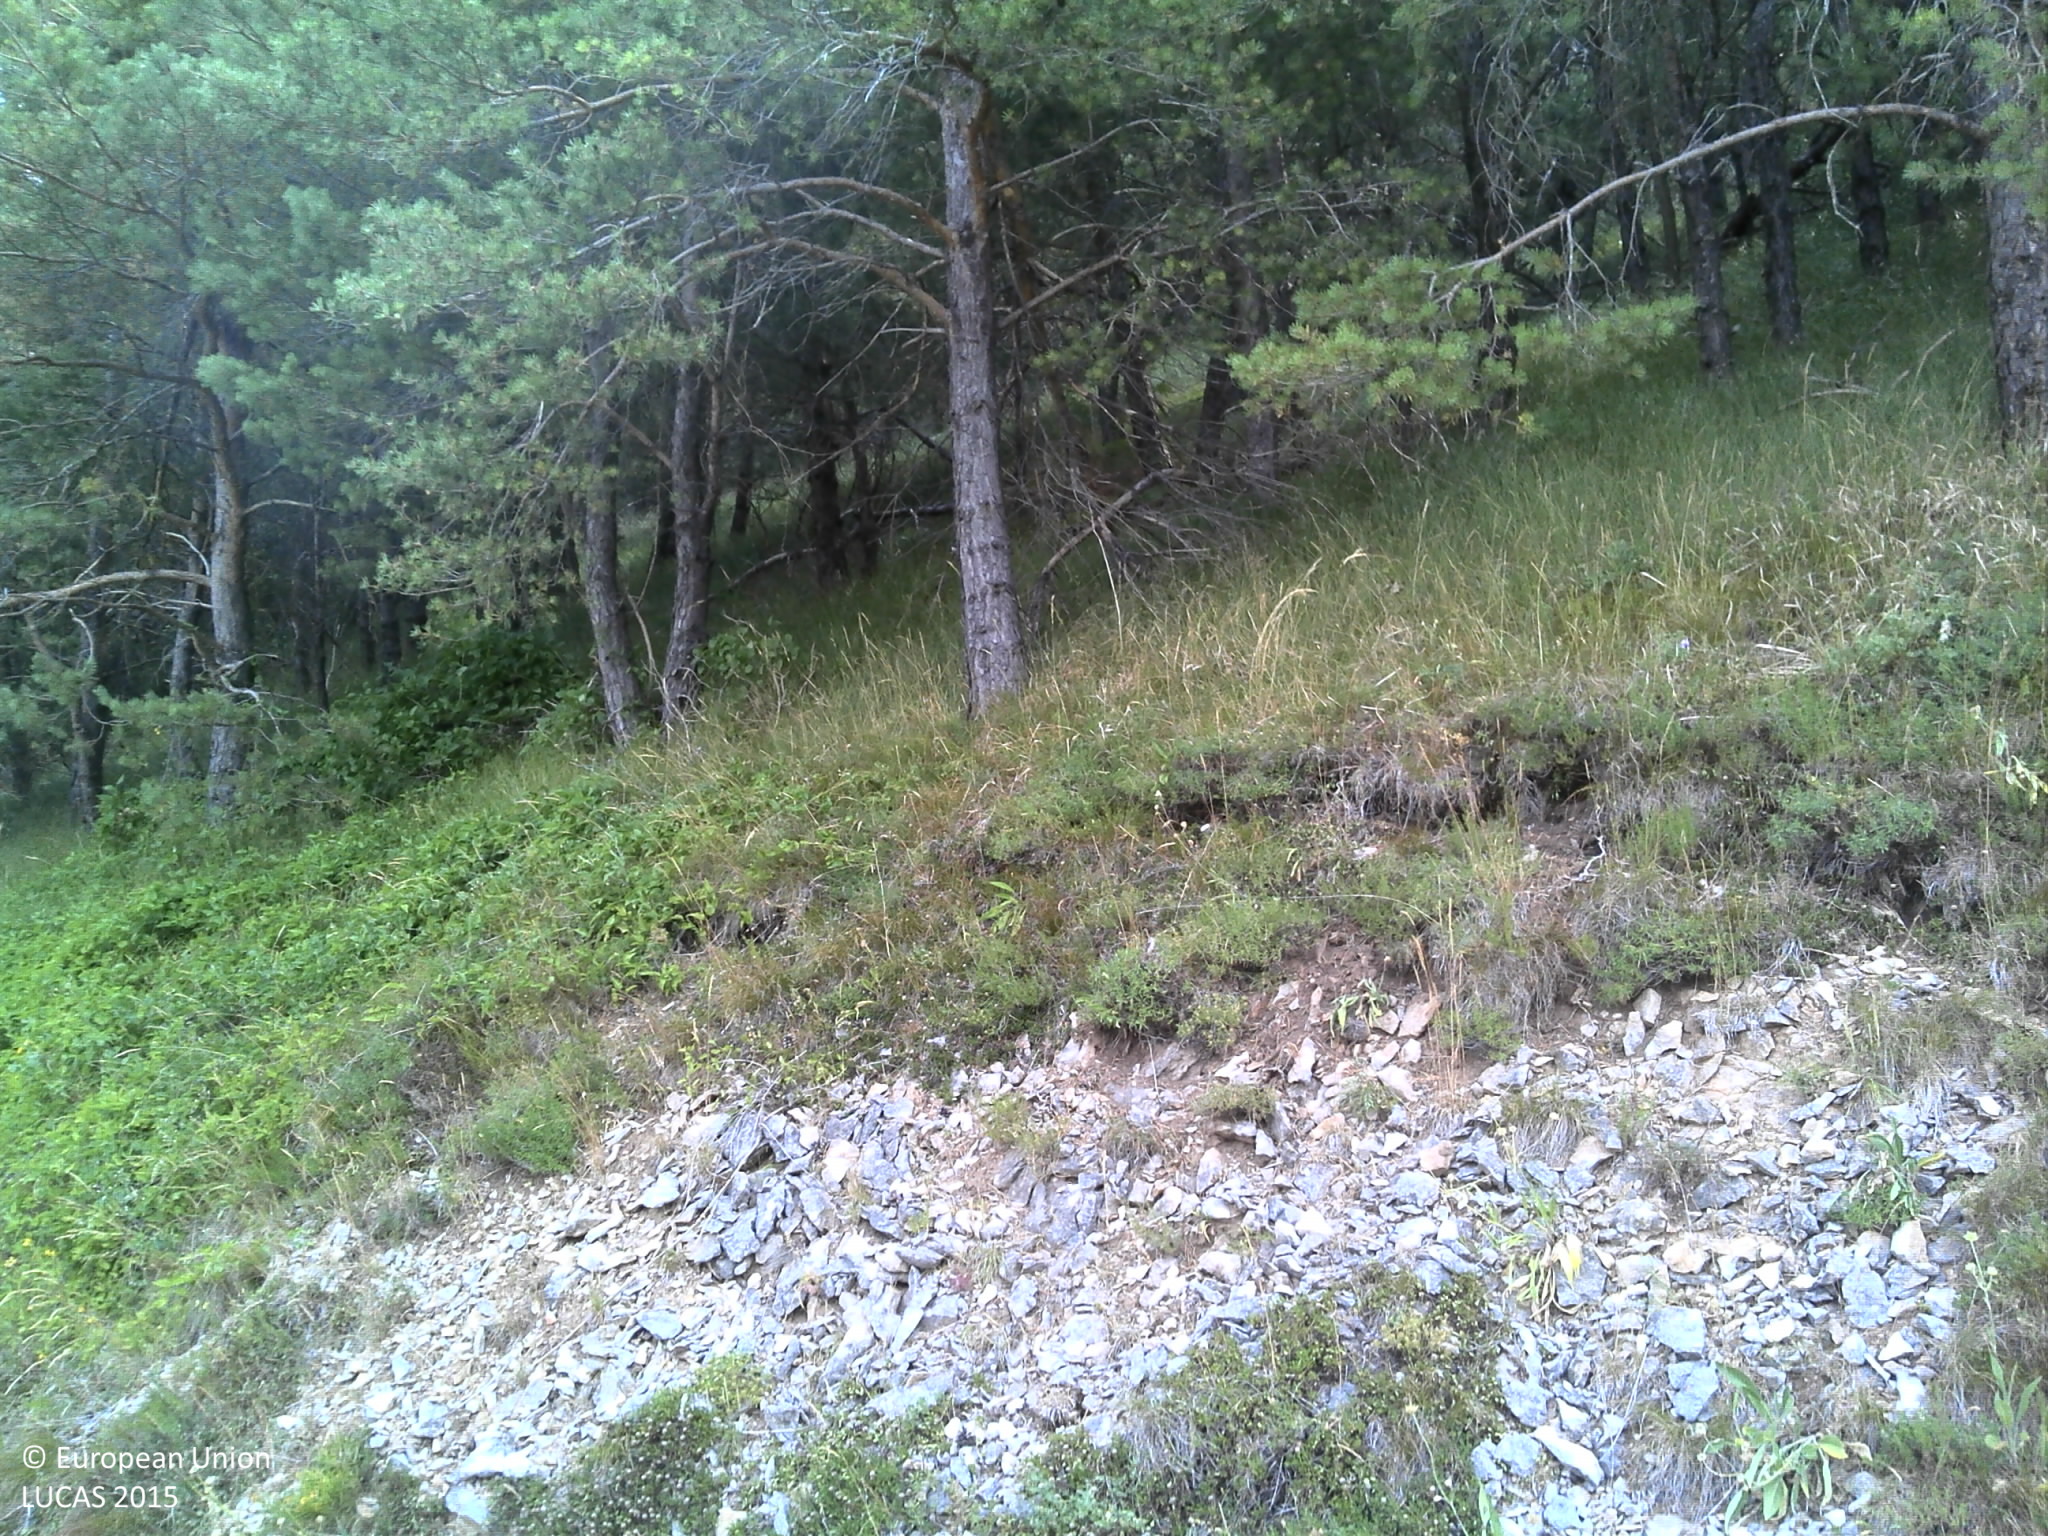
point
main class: Woodland
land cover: Pine dominated coniferous woodland
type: coniferous forest of the mediterranean region
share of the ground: > 75 %
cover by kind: coniferous forest trees 80 %, herbaceous plants 10 %, broadleaved forest trees 5 %, consolidated bare surface 5 %
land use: Semi-natural and natural areas not in use
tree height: > 5 m
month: July
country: HR
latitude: 44.2784
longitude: 16.1202
